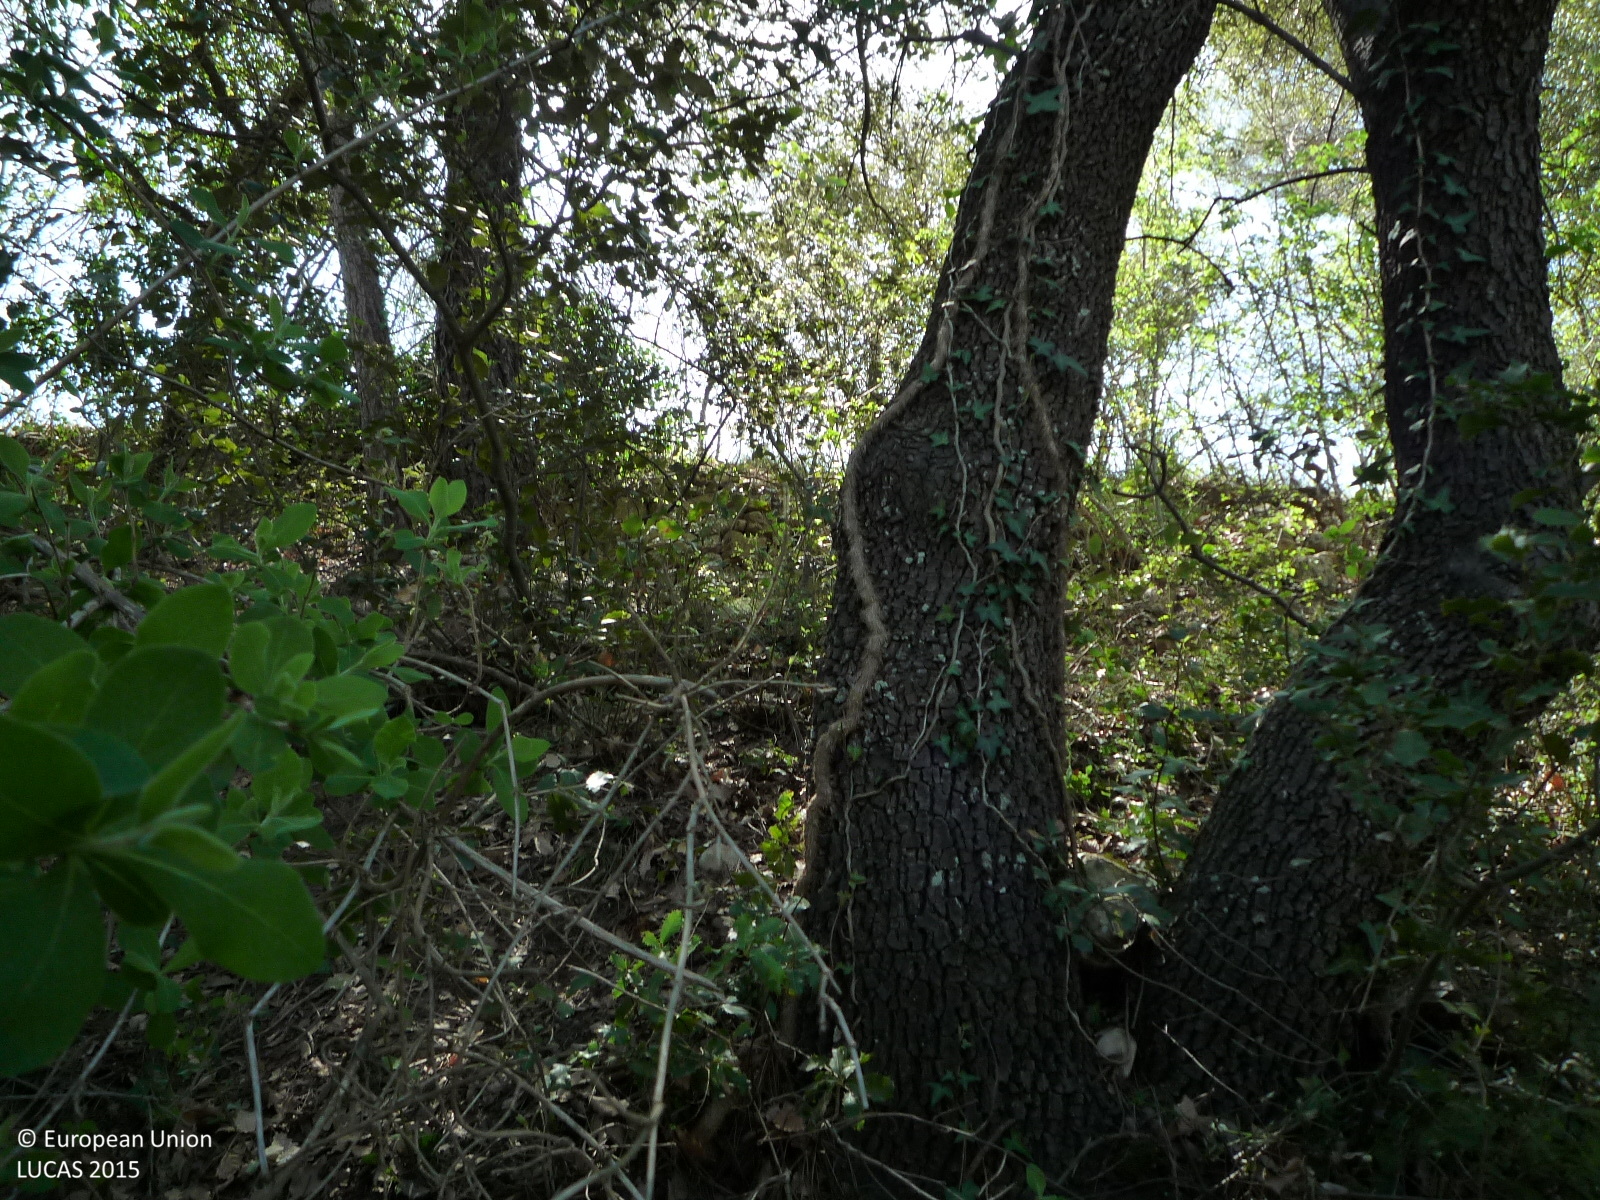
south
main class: Woodland
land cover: Pine dominated mixed woodland
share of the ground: > 75 %
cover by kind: coniferous forest trees 55 %, broadleaved forest trees 45 %
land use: Semi-natural and natural areas not in use
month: April
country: ES
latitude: 41.5292
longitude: 1.6626
